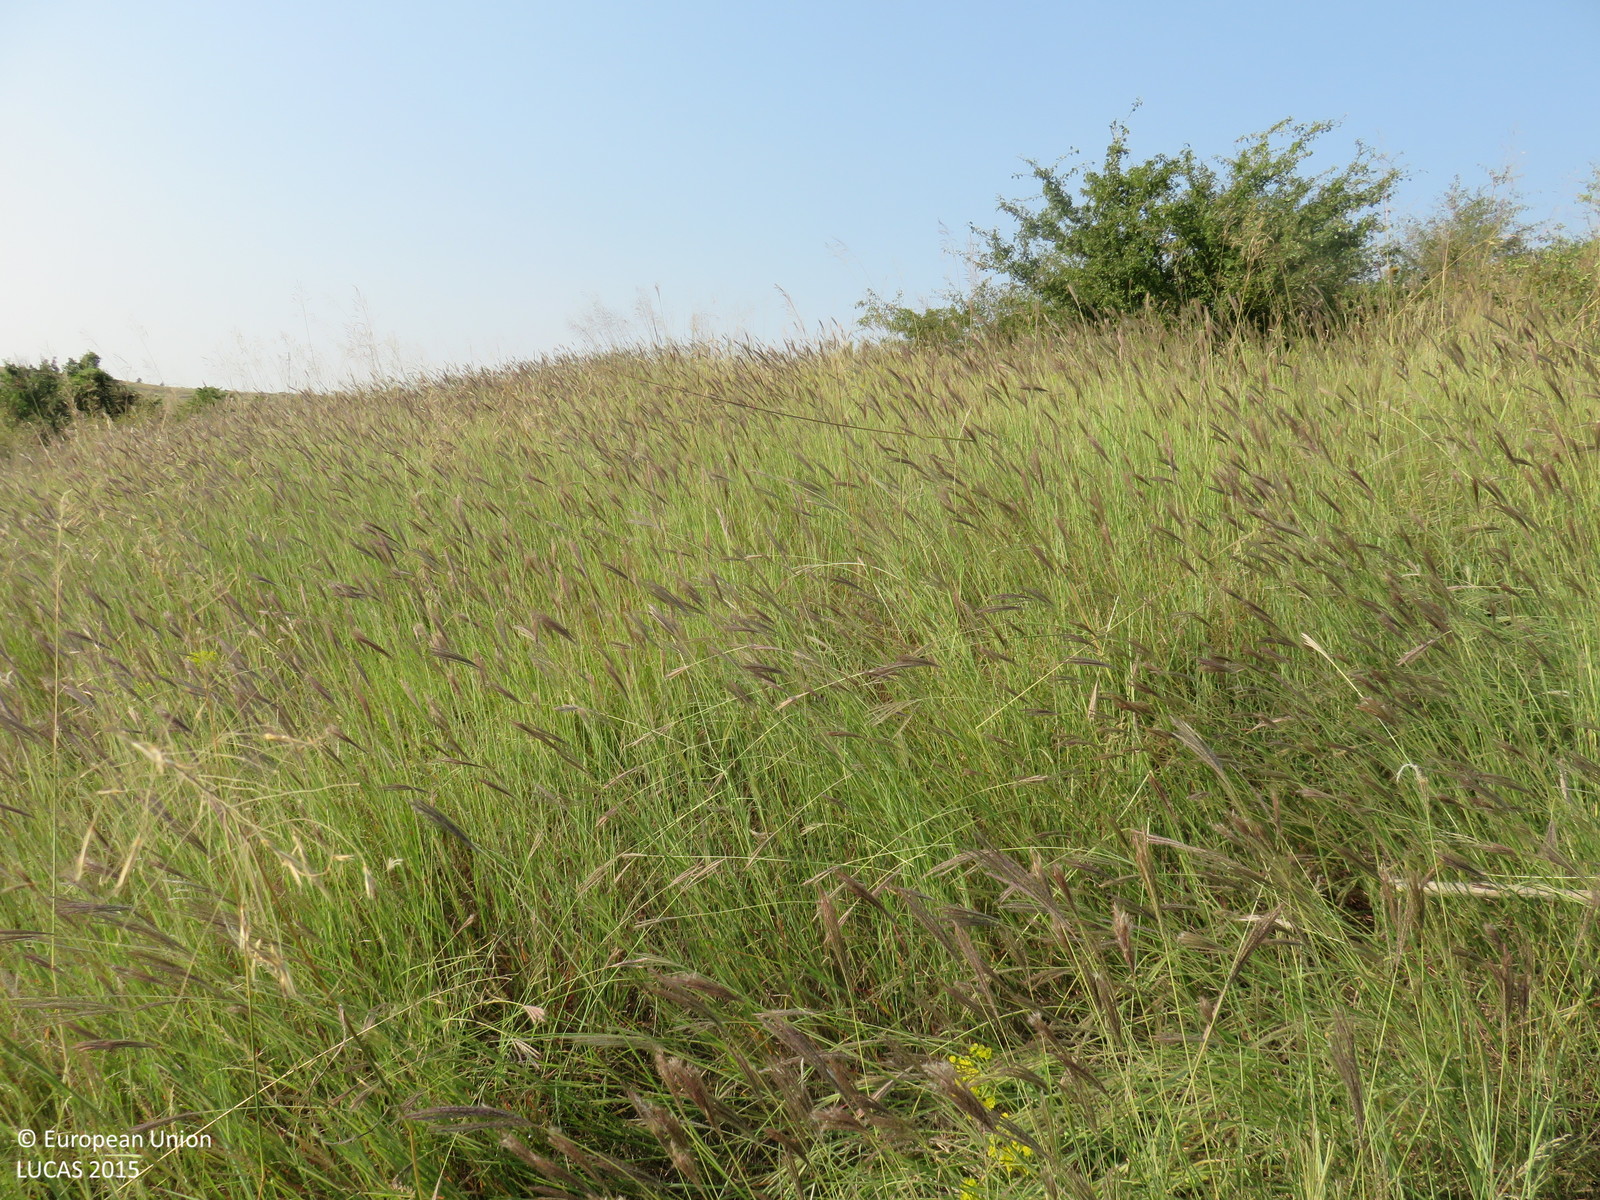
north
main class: Grassland
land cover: Grassland with sparse tree/shrub cover
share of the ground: > 75 %
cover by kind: herbaceous plants 90 %, broadleaved forest trees 5 %, shrubs 5 %
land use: Agriculture (excluding fallow land and kitchen gardens)
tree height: < 5 m
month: July
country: BG
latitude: 43.6010
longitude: 25.0000
